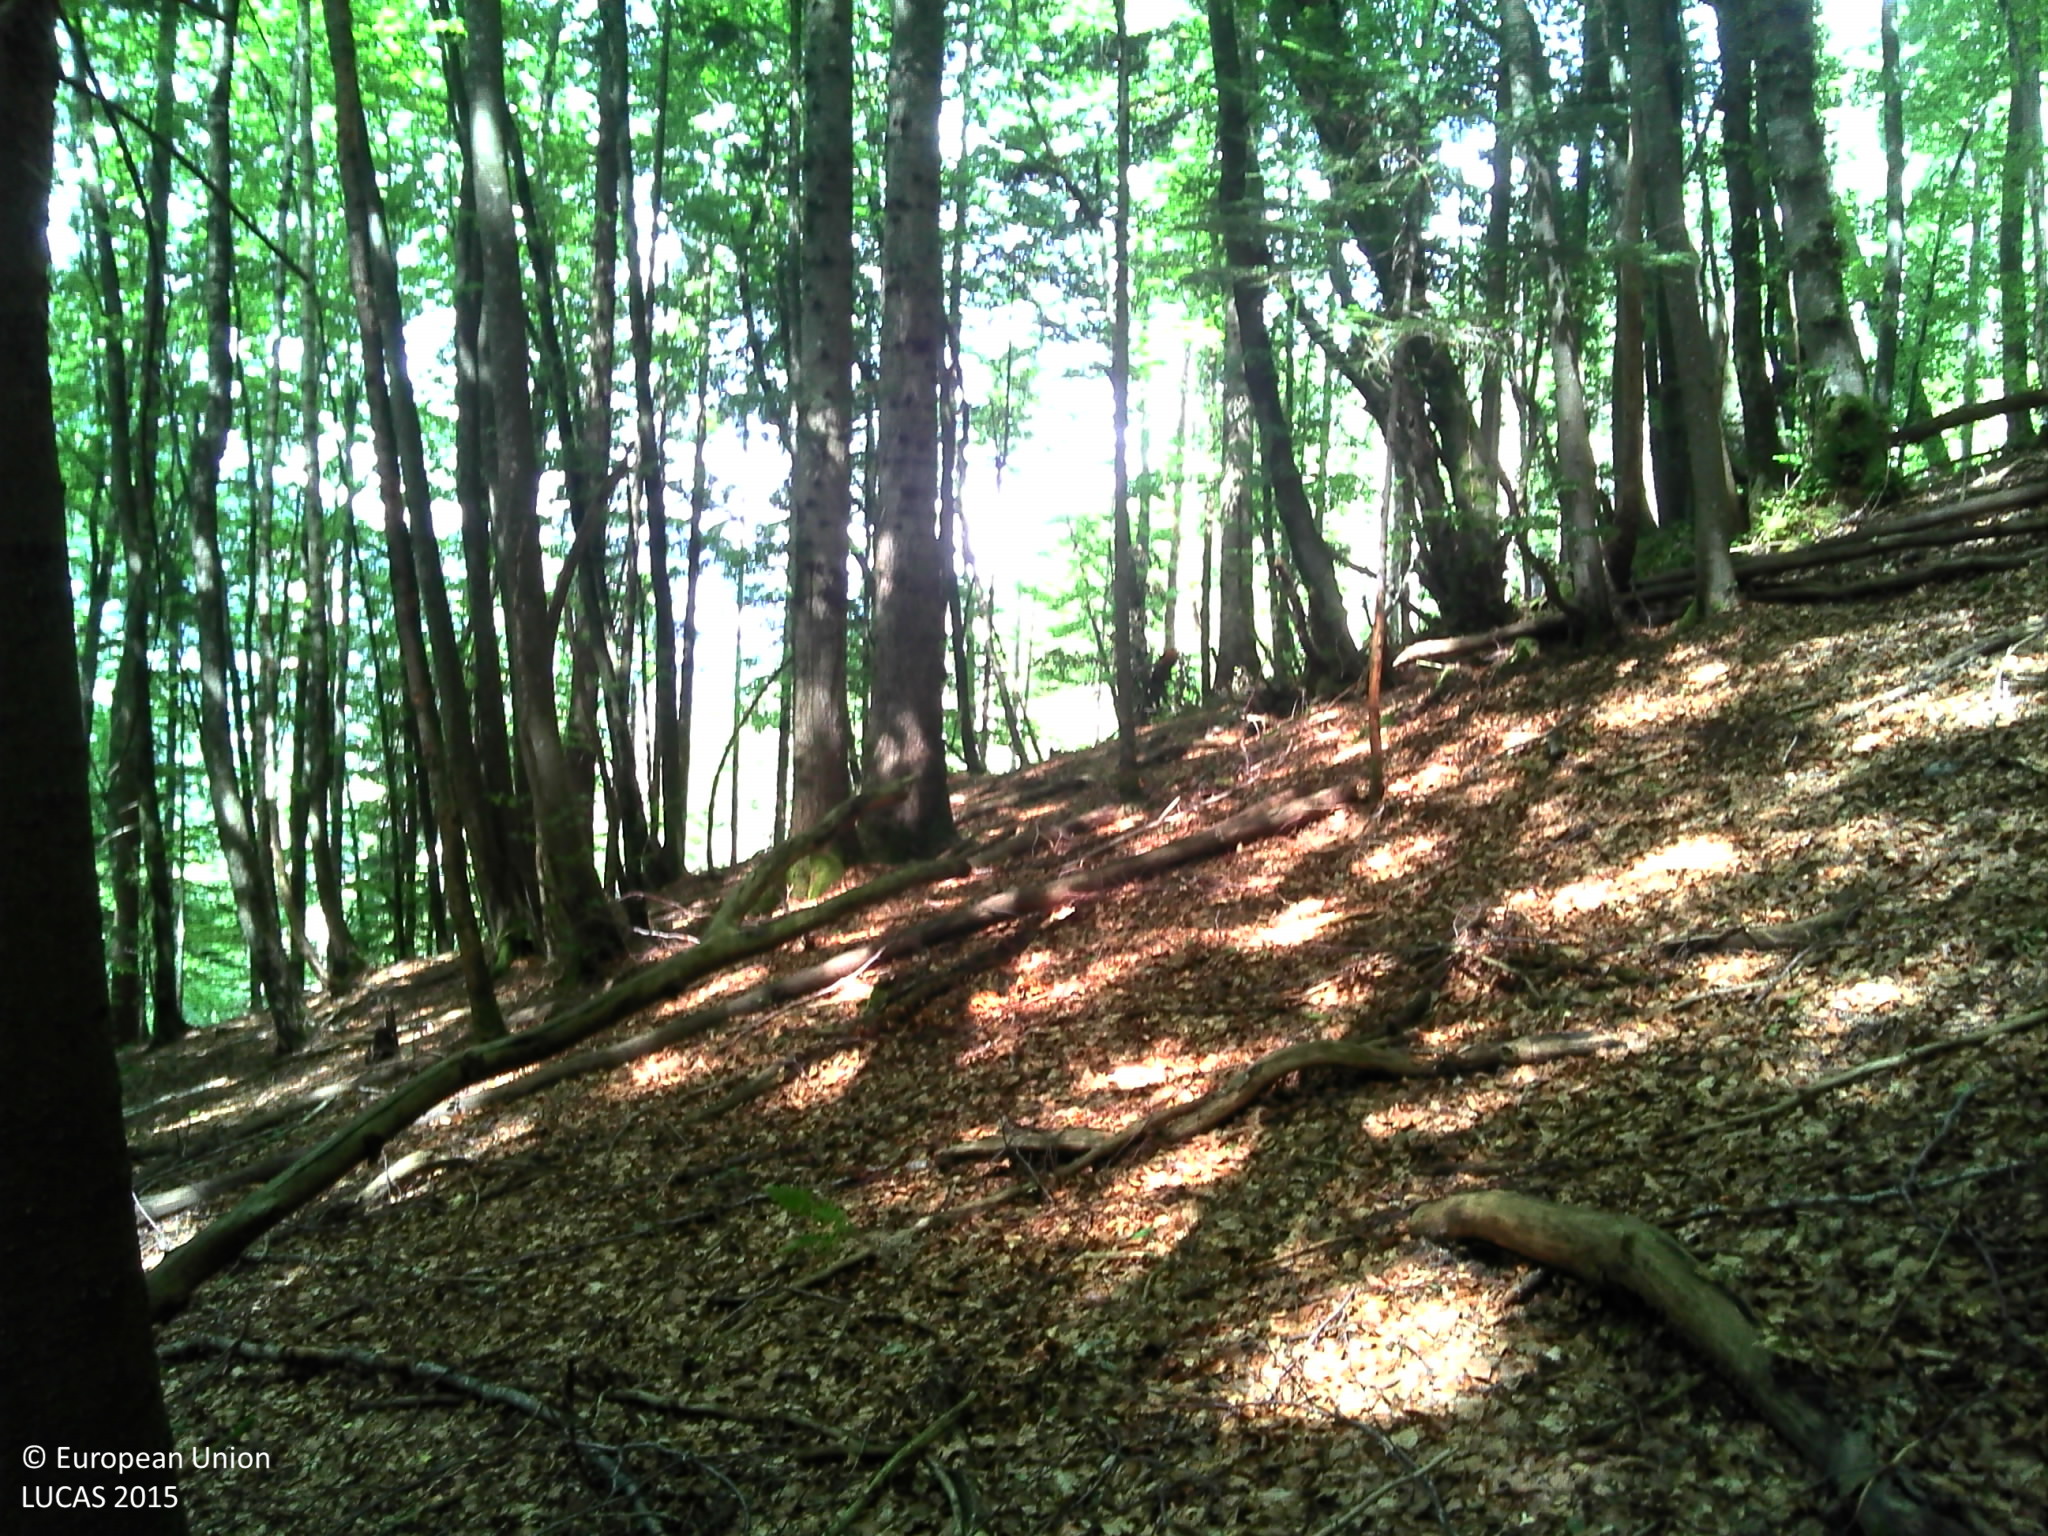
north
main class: Woodland
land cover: Broadleaved woodland
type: beech forest
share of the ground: > 75 %
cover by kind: broadleaved forest trees 75 %, coniferous forest trees 15 %, herbaceous plants 5 %, lichens and mosses 5 %
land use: Forestry
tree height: > 5 m
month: July
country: FR
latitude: 46.1307
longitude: 6.4701
